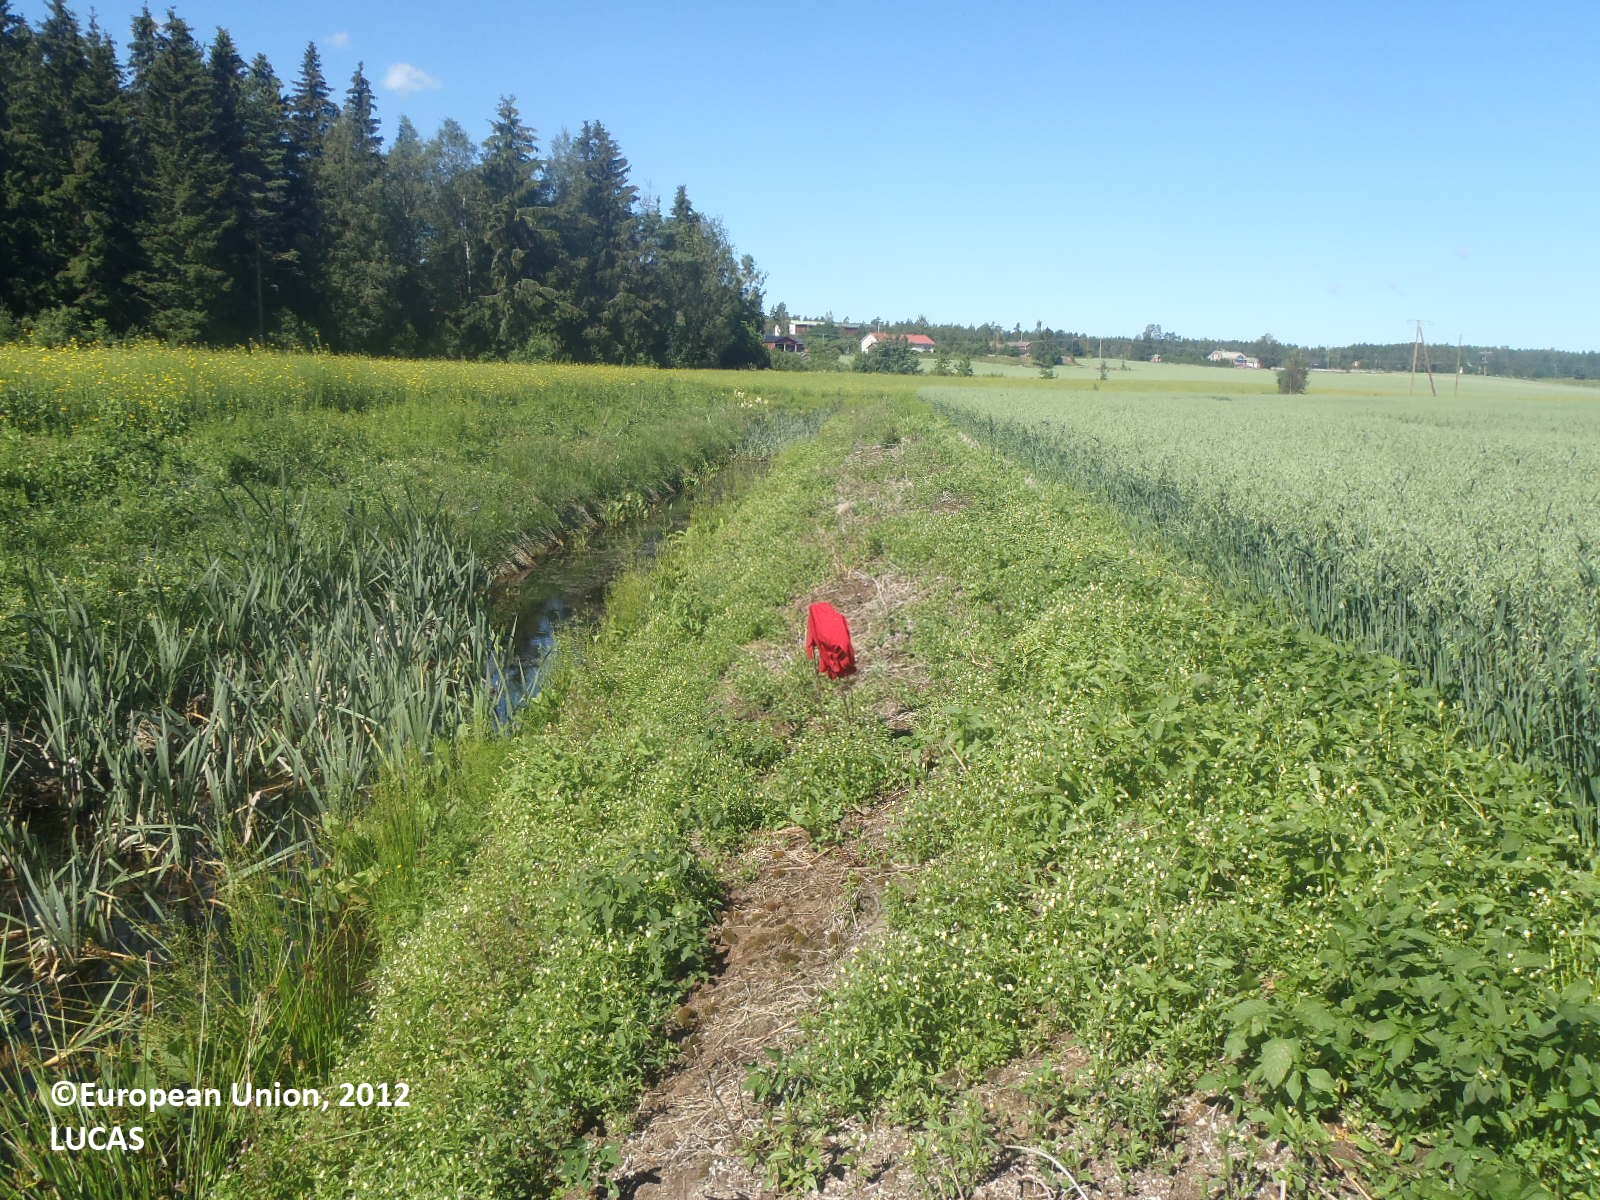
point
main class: Cropland
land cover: Oats
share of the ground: > 75 %
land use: Agriculture (excluding fallow land and kitchen gardens)
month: July
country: FI
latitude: 61.0438
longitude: 21.8902
